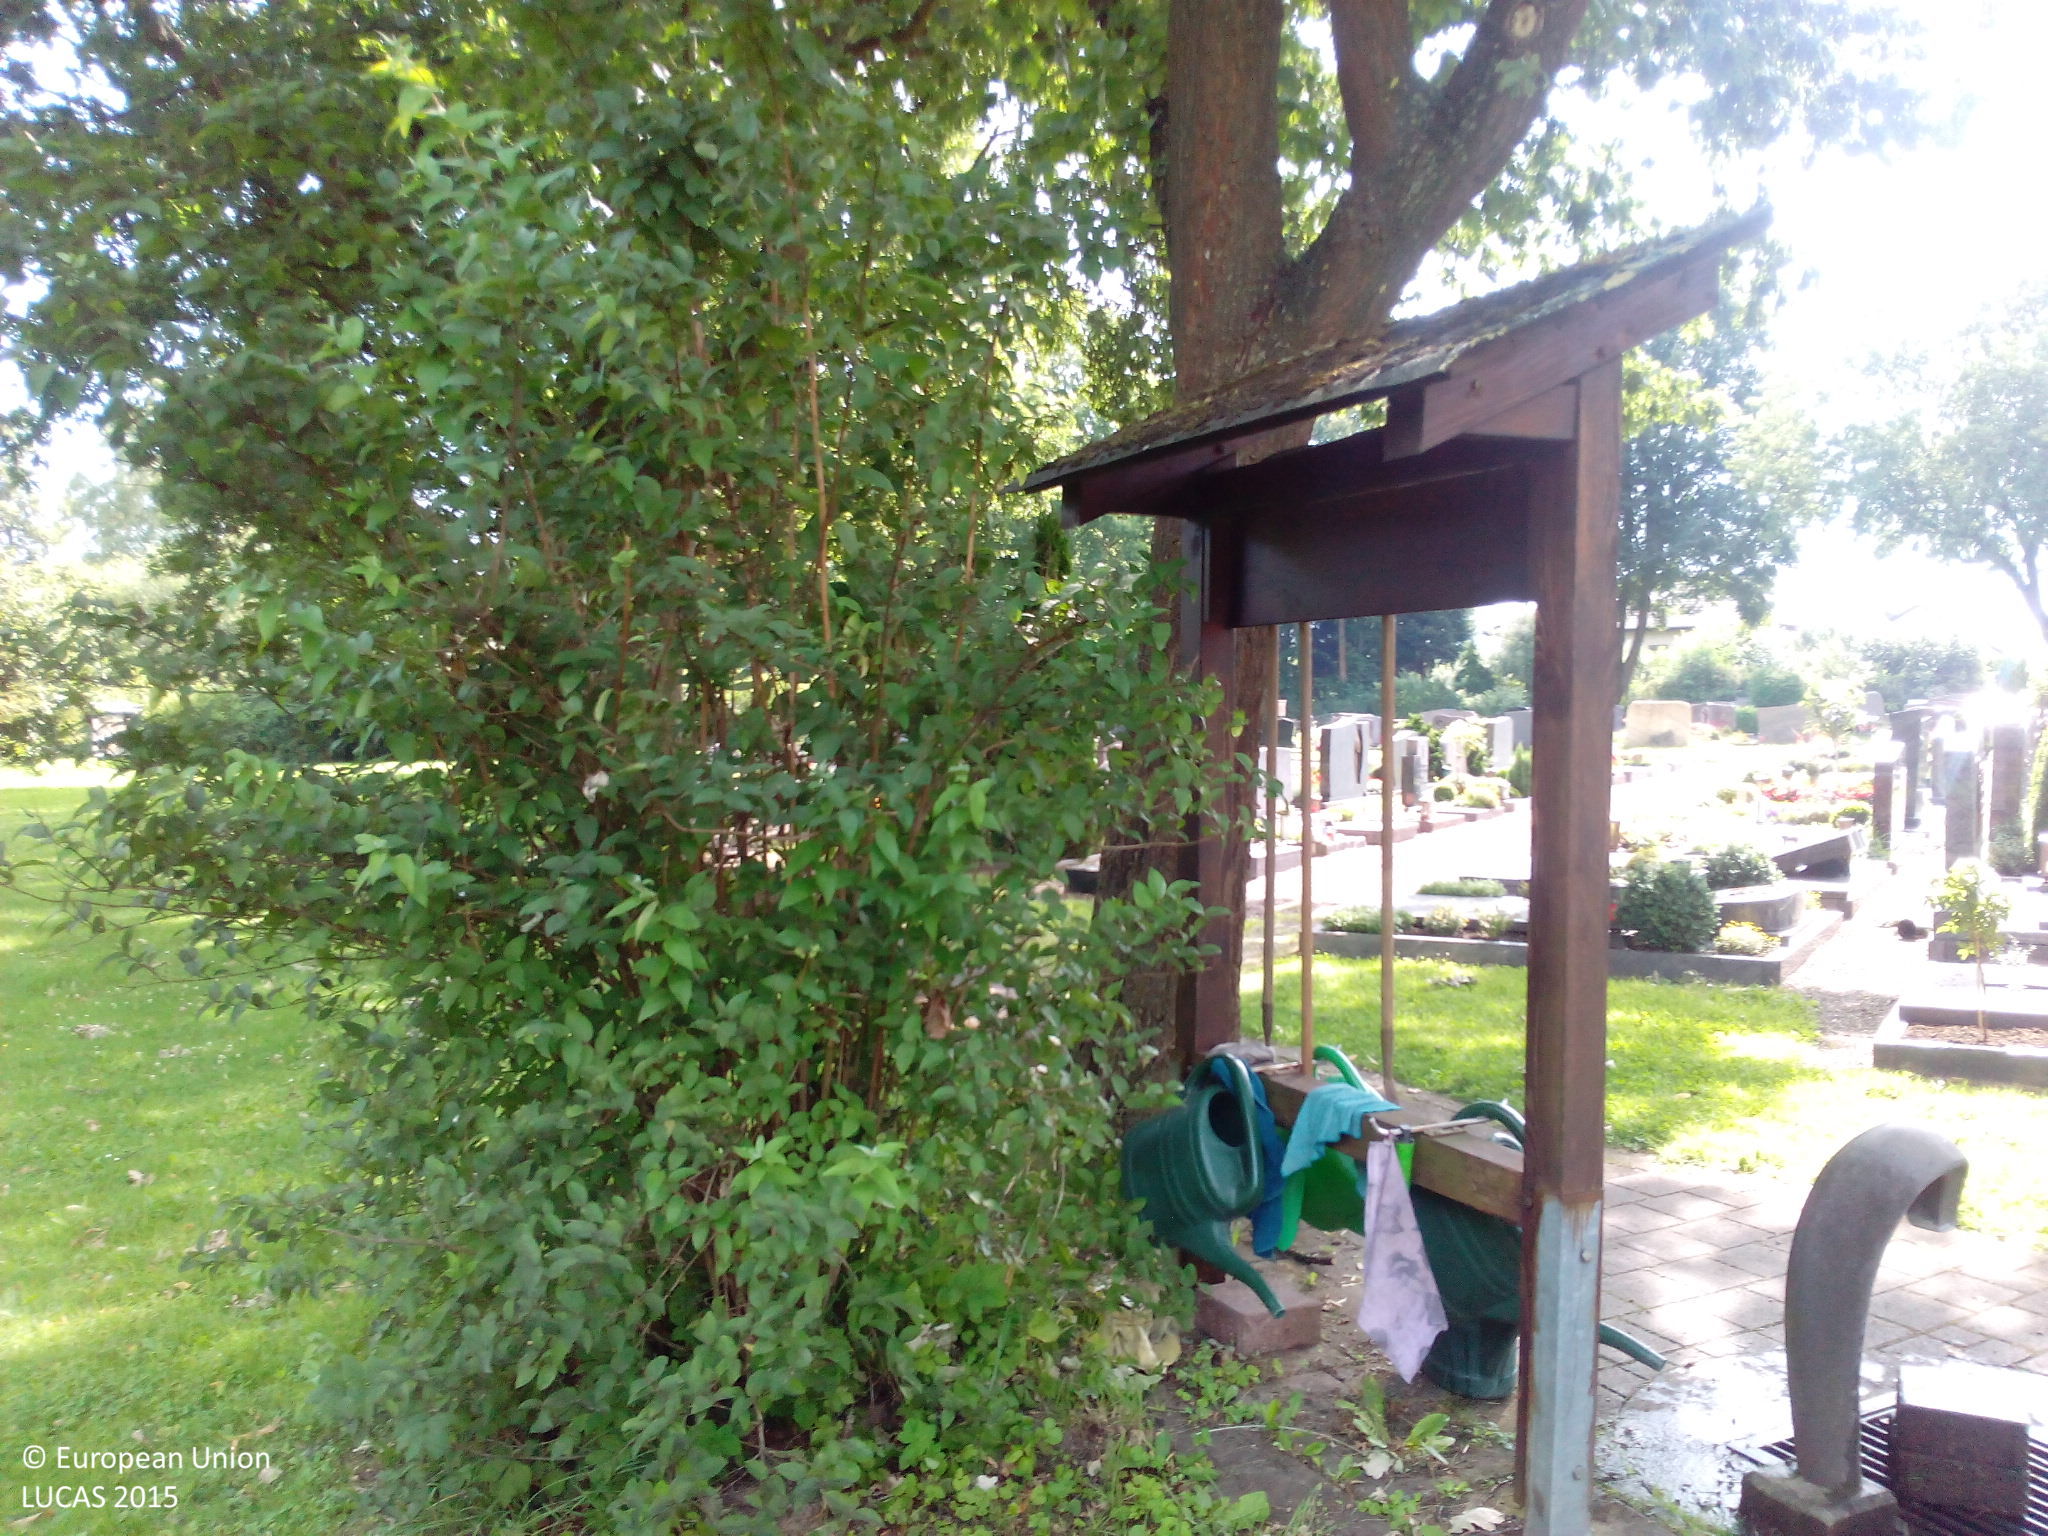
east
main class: Grassland
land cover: Grassland with sparse tree/shrub cover
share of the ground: > 75 %
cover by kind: herbaceous plants 95 %, broadleaved forest trees 5 %
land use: Community services
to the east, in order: Grassland with sparse tree/shrub cover; Artificial constructions in urban areas
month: August
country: DE
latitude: 51.8005
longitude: 9.3477
